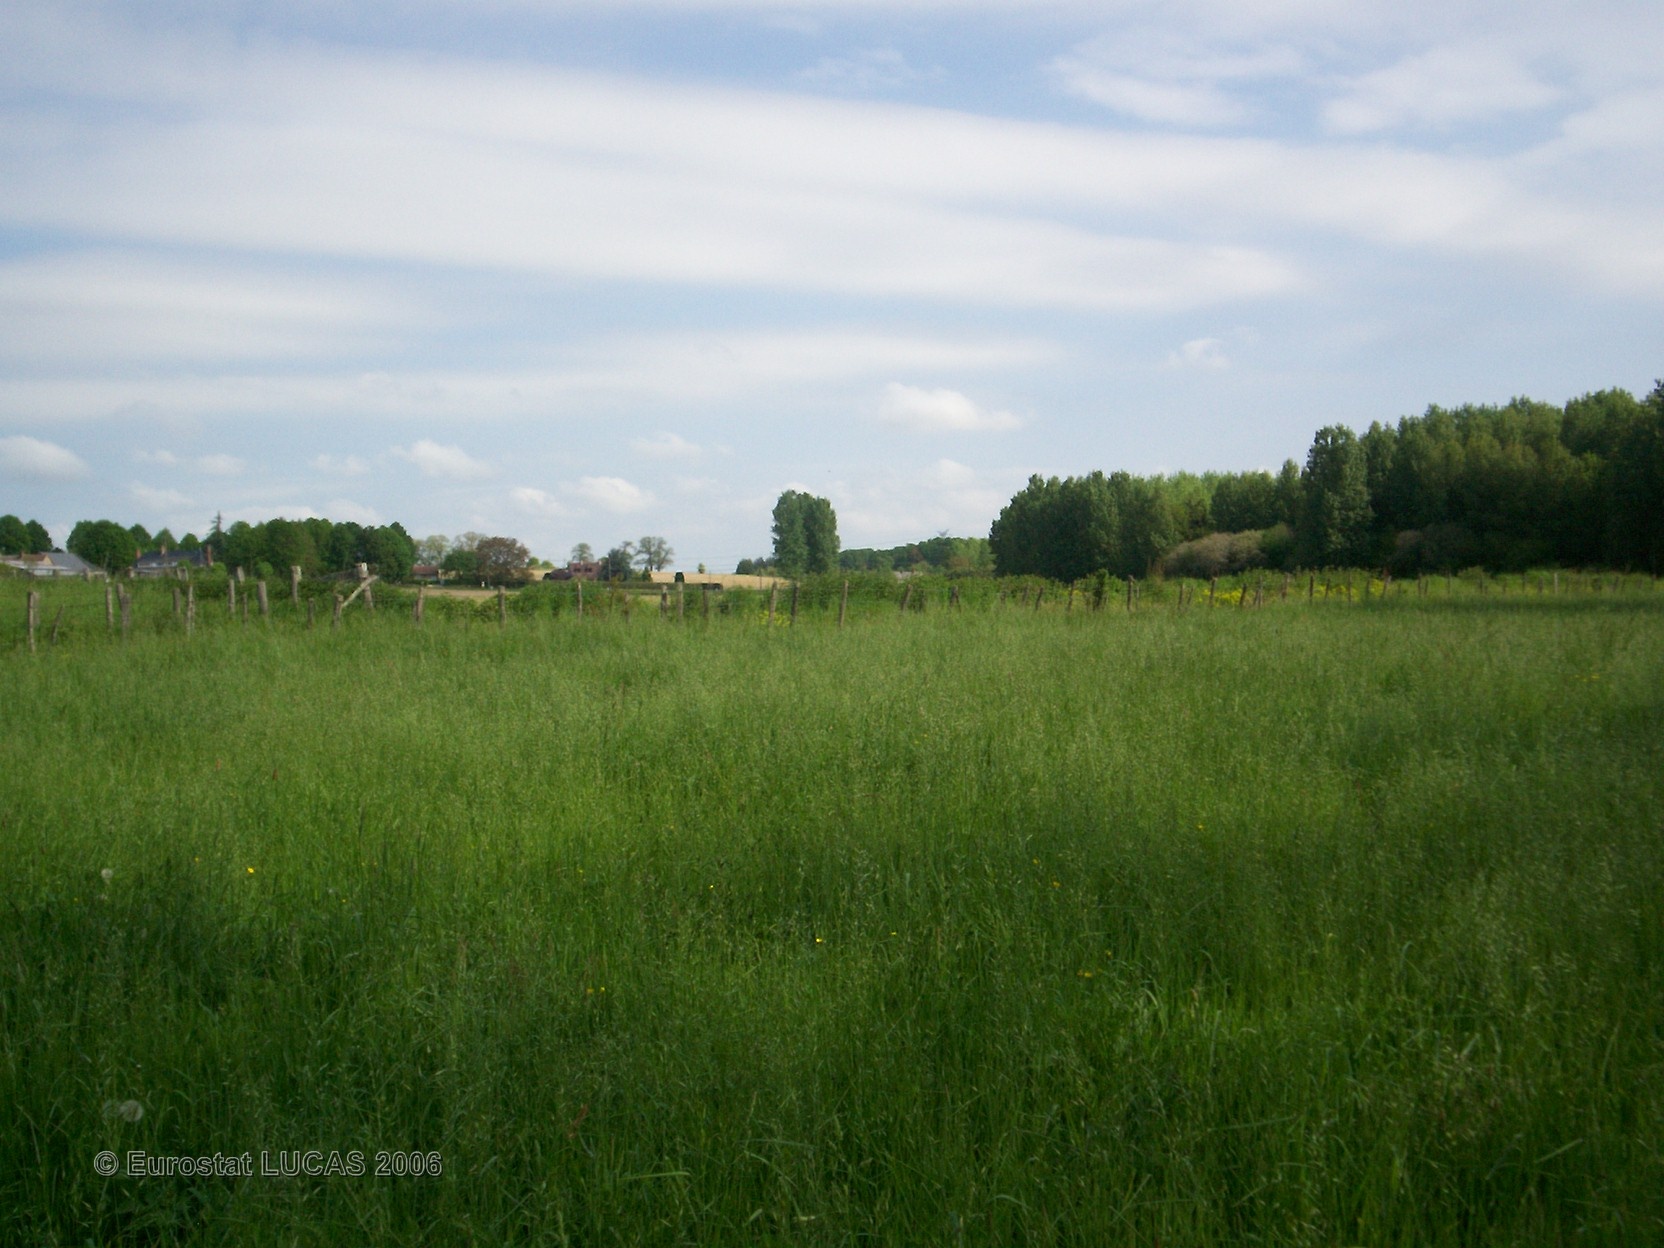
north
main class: Grassland
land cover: Grassland without tree/shrub cover
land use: Agriculture (excluding fallow land and kitchen gardens)
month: May
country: FR
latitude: 47.8184
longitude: 0.1577
